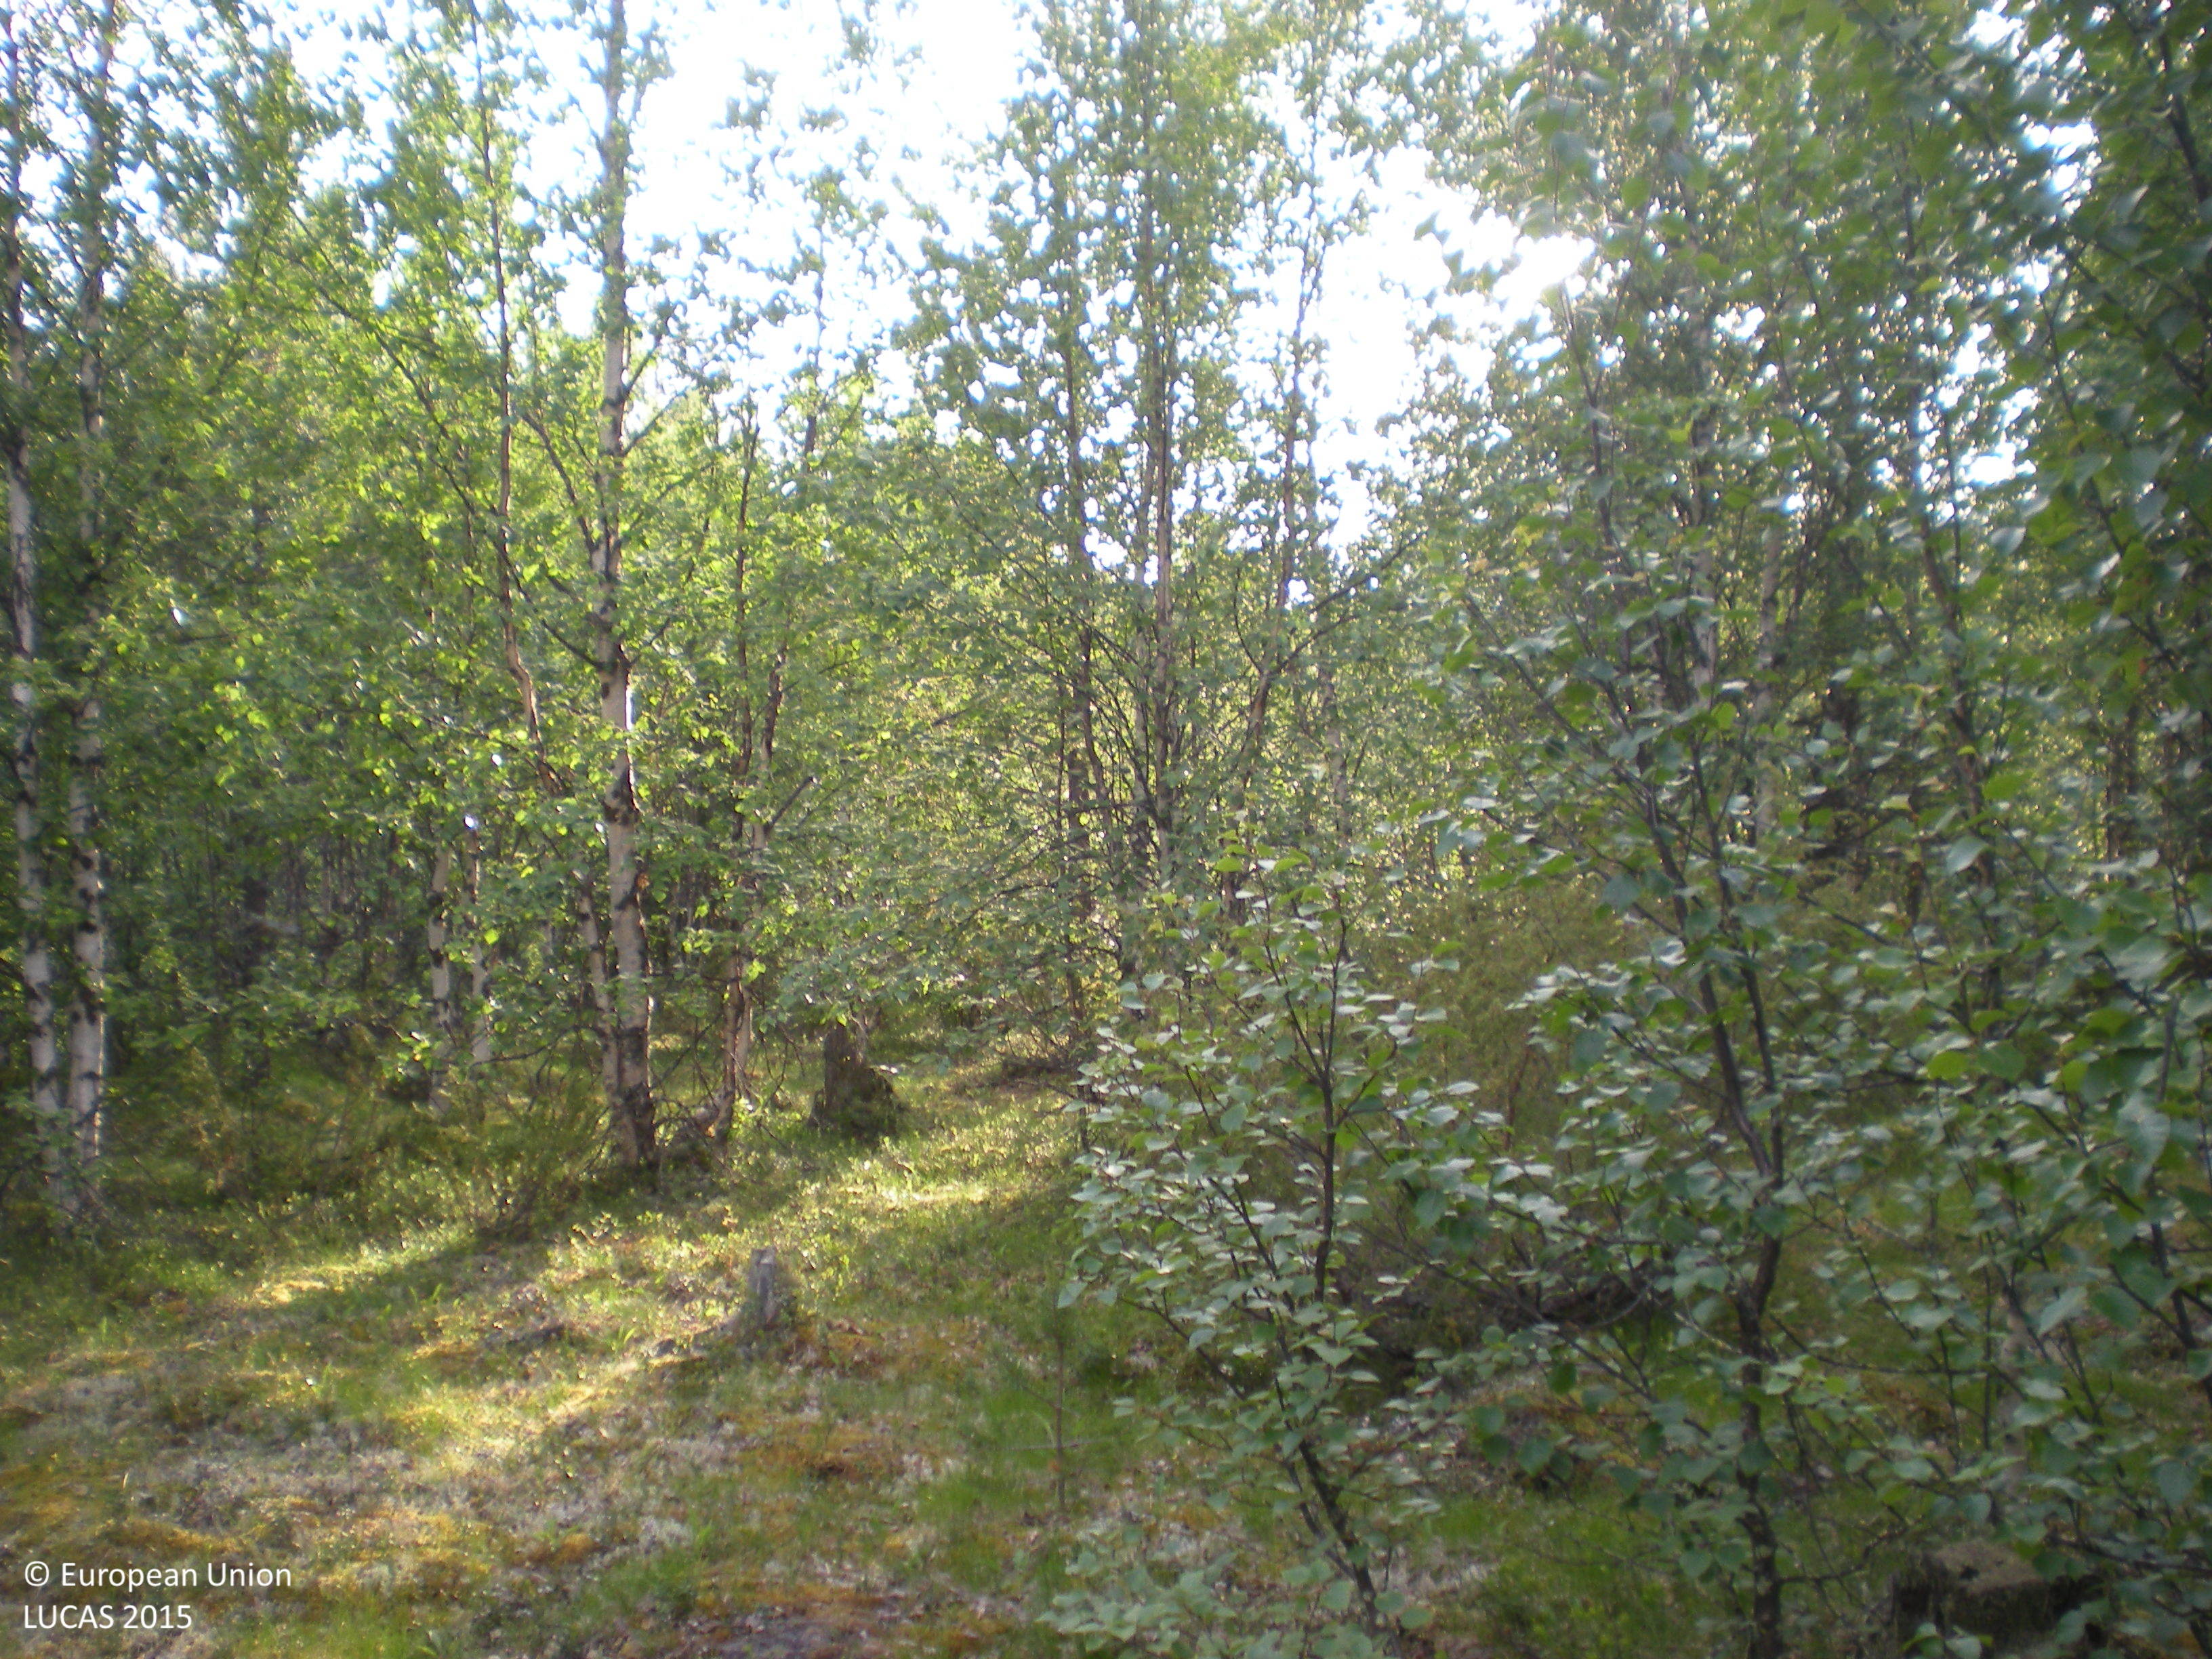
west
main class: Woodland
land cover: Broadleaved woodland
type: boreal forest
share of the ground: 50 - 75 %
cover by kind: broadleaved forest trees 70 %, lichens and mosses 15 %, herbaceous plants 10 %, shrubs 5 %
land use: Forestry
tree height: > 5 m
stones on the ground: > 50 %
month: July
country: SE
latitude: 65.6097
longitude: 17.7066
